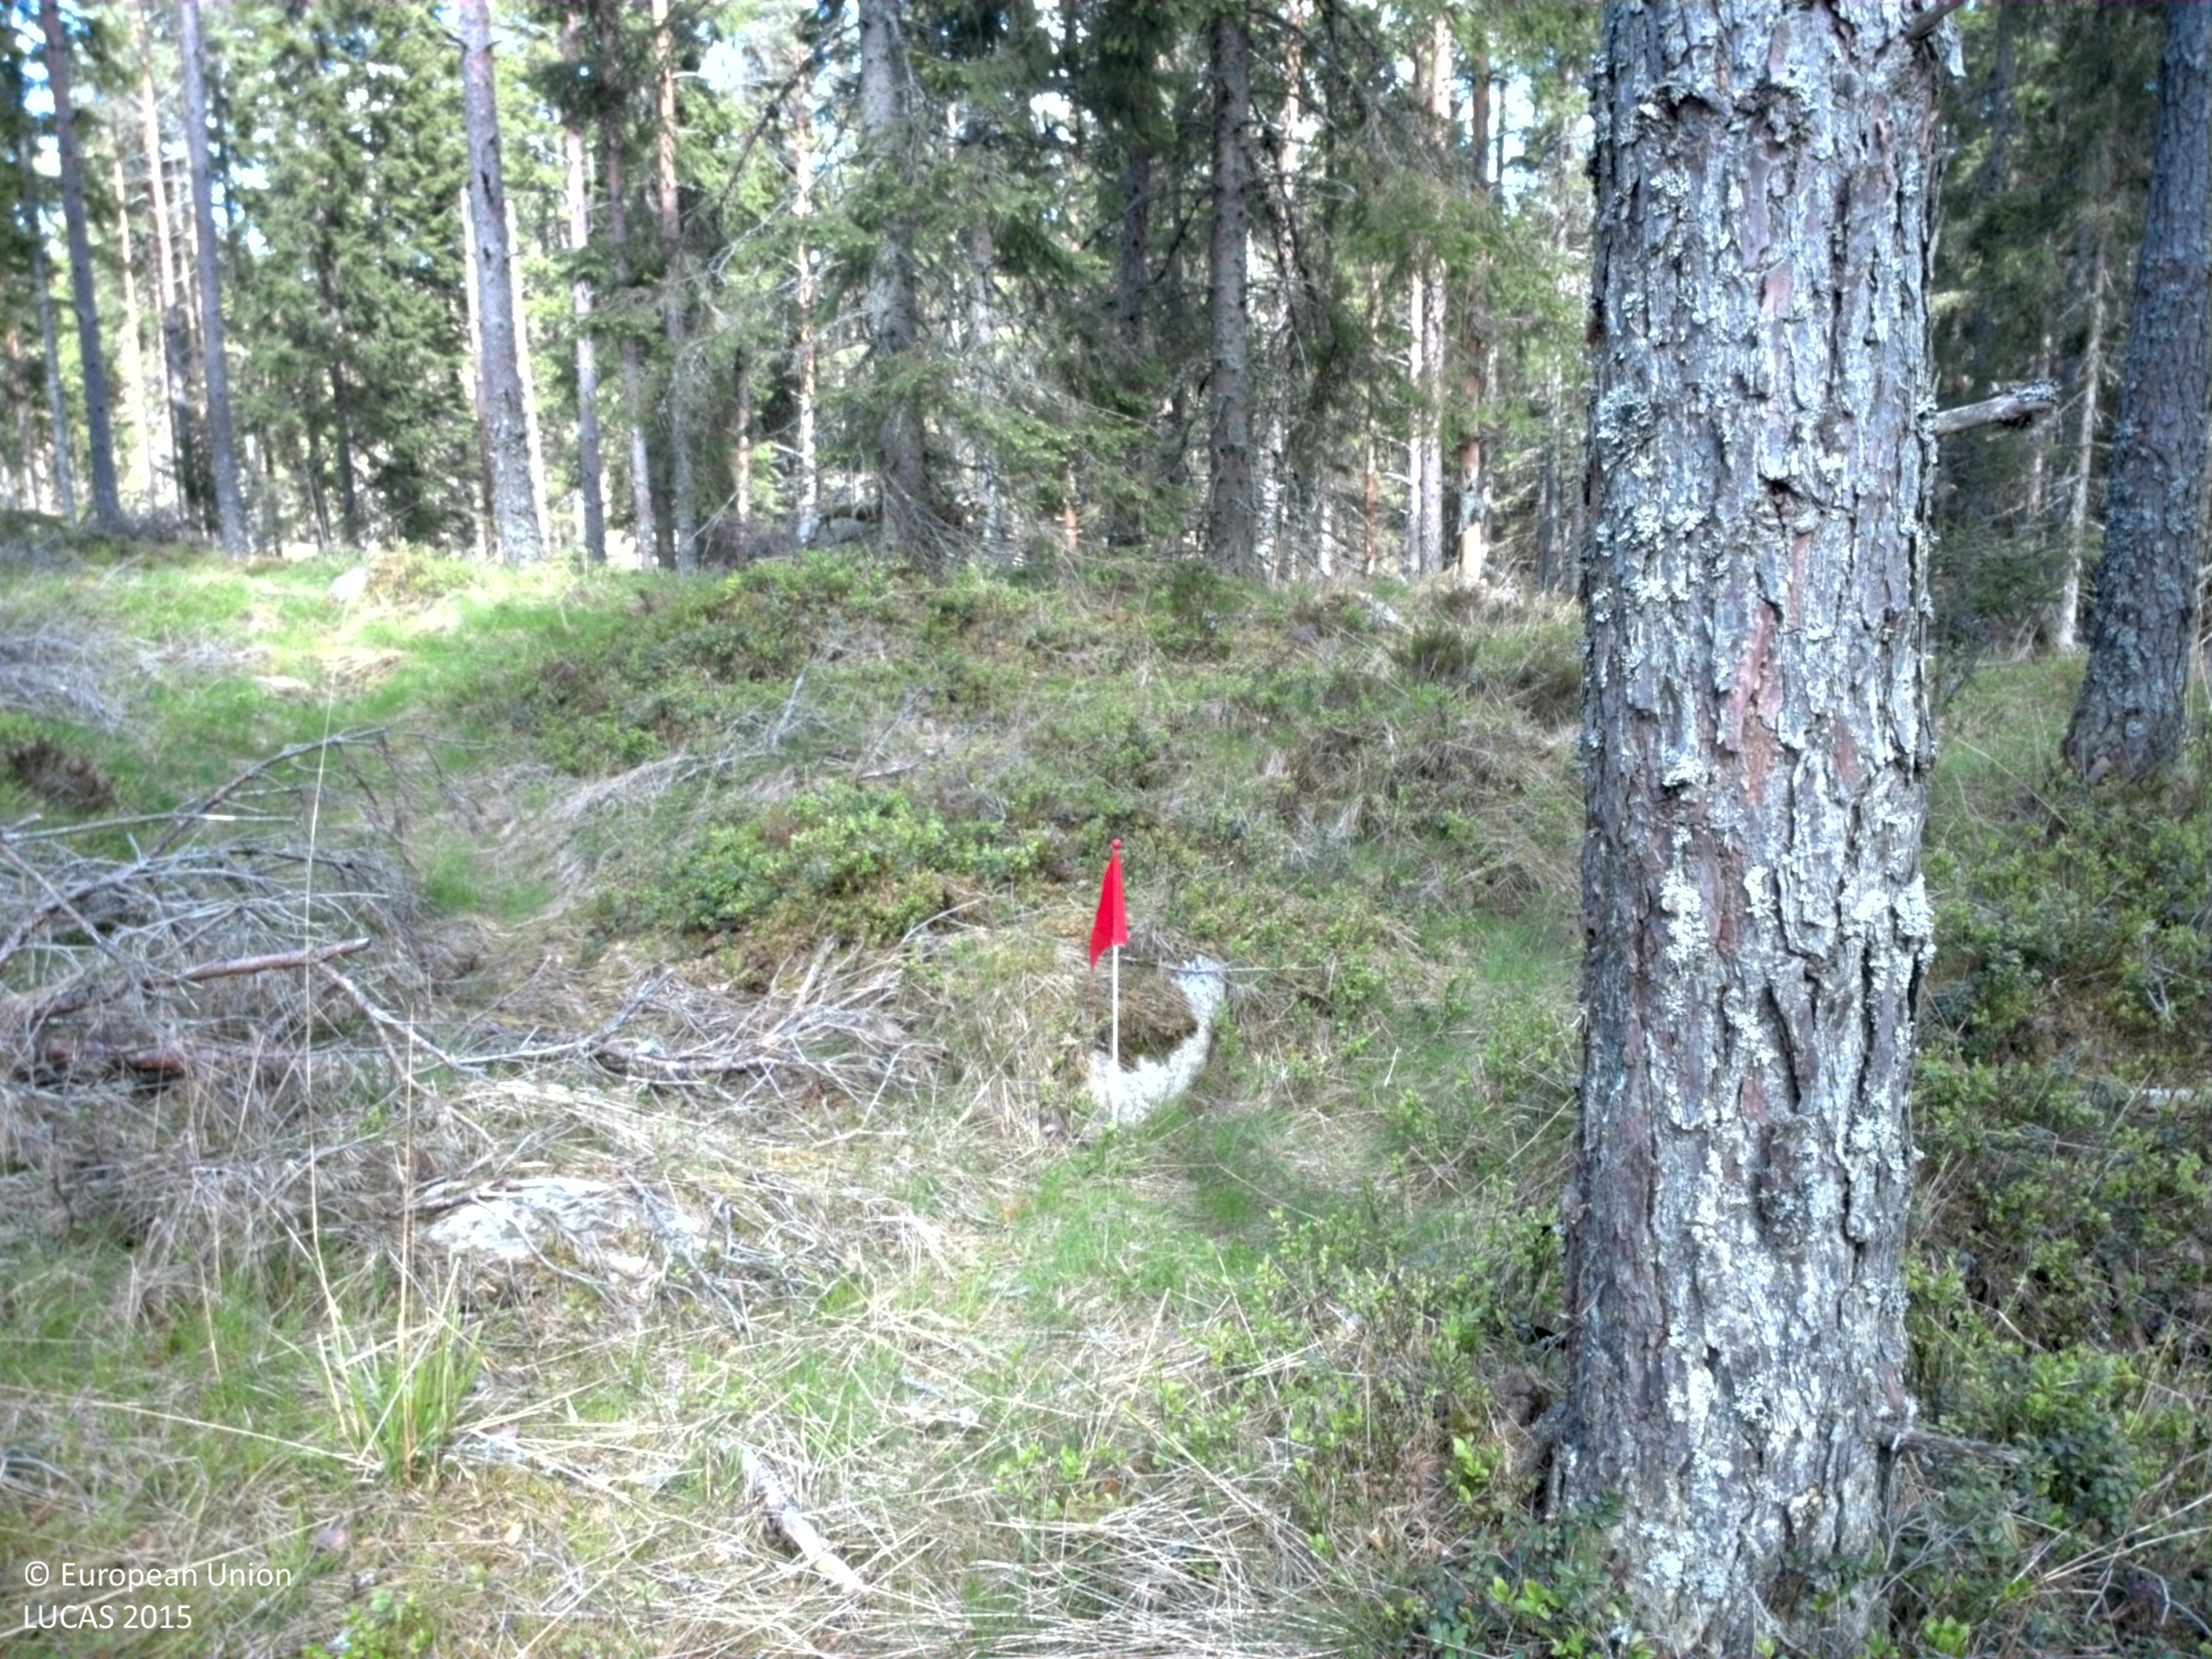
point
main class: Woodland
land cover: Spruce dominated coniferous woodland
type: boreal forest
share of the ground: > 75 %
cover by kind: coniferous forest trees 75 %, shrubs 10 %, broadleaved forest trees 5 %, herbaceous plants 5 %, lichens and mosses 5 %
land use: Forestry
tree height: > 5 m
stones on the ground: 25 - 50 %
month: May
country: SE
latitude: 59.4776
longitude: 12.3065
